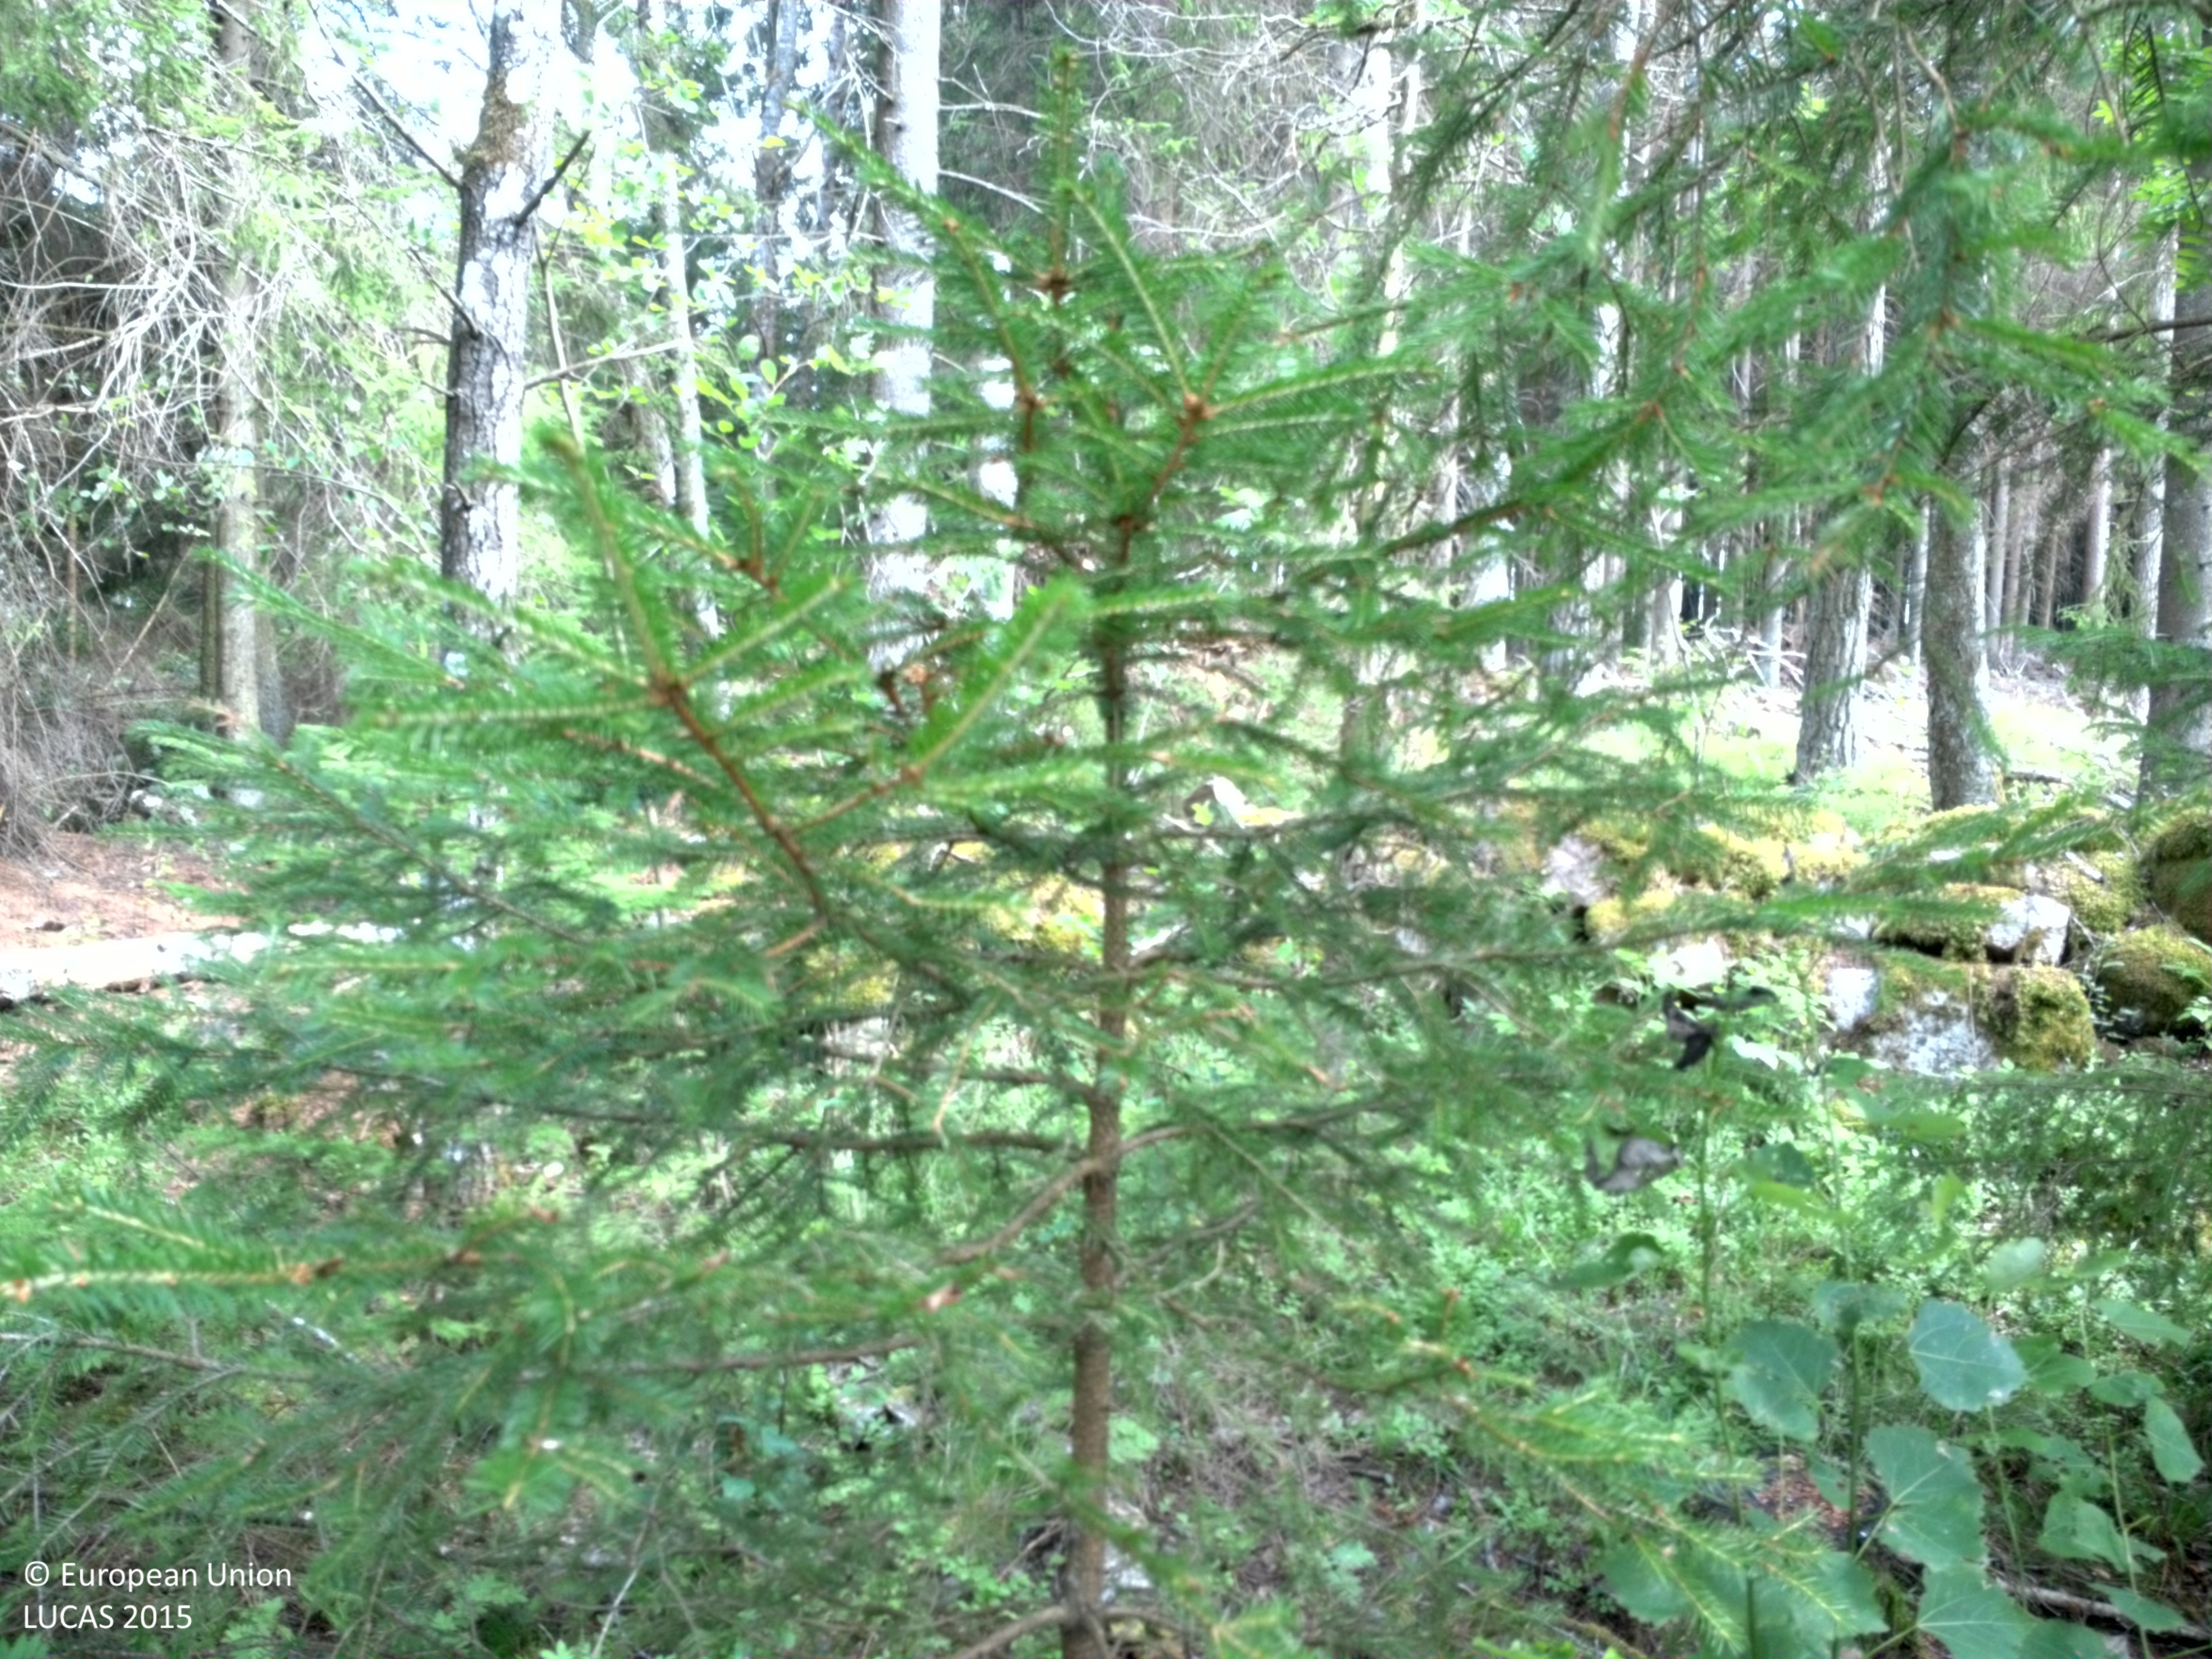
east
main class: Woodland
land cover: Spruce dominated mixed woodland
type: boreal forest
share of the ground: 50 - 75 %
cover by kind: broadleaved forest trees 35 %, coniferous forest trees 30 %, shrubs 15 %, herbaceous plants 10 %, lichens and mosses 10 %
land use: Forestry
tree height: > 5 m
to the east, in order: Spruce dominated mixed woodland; Dry stone walls; Spruce dominated mixed woodland; Spruce dominated coniferous woodland; Paved roads, cycling and walking lanes; Grassland with sparse tree/shrub cover; Broadleaved woodland
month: July
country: SE
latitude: 58.1813
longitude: 13.8885
